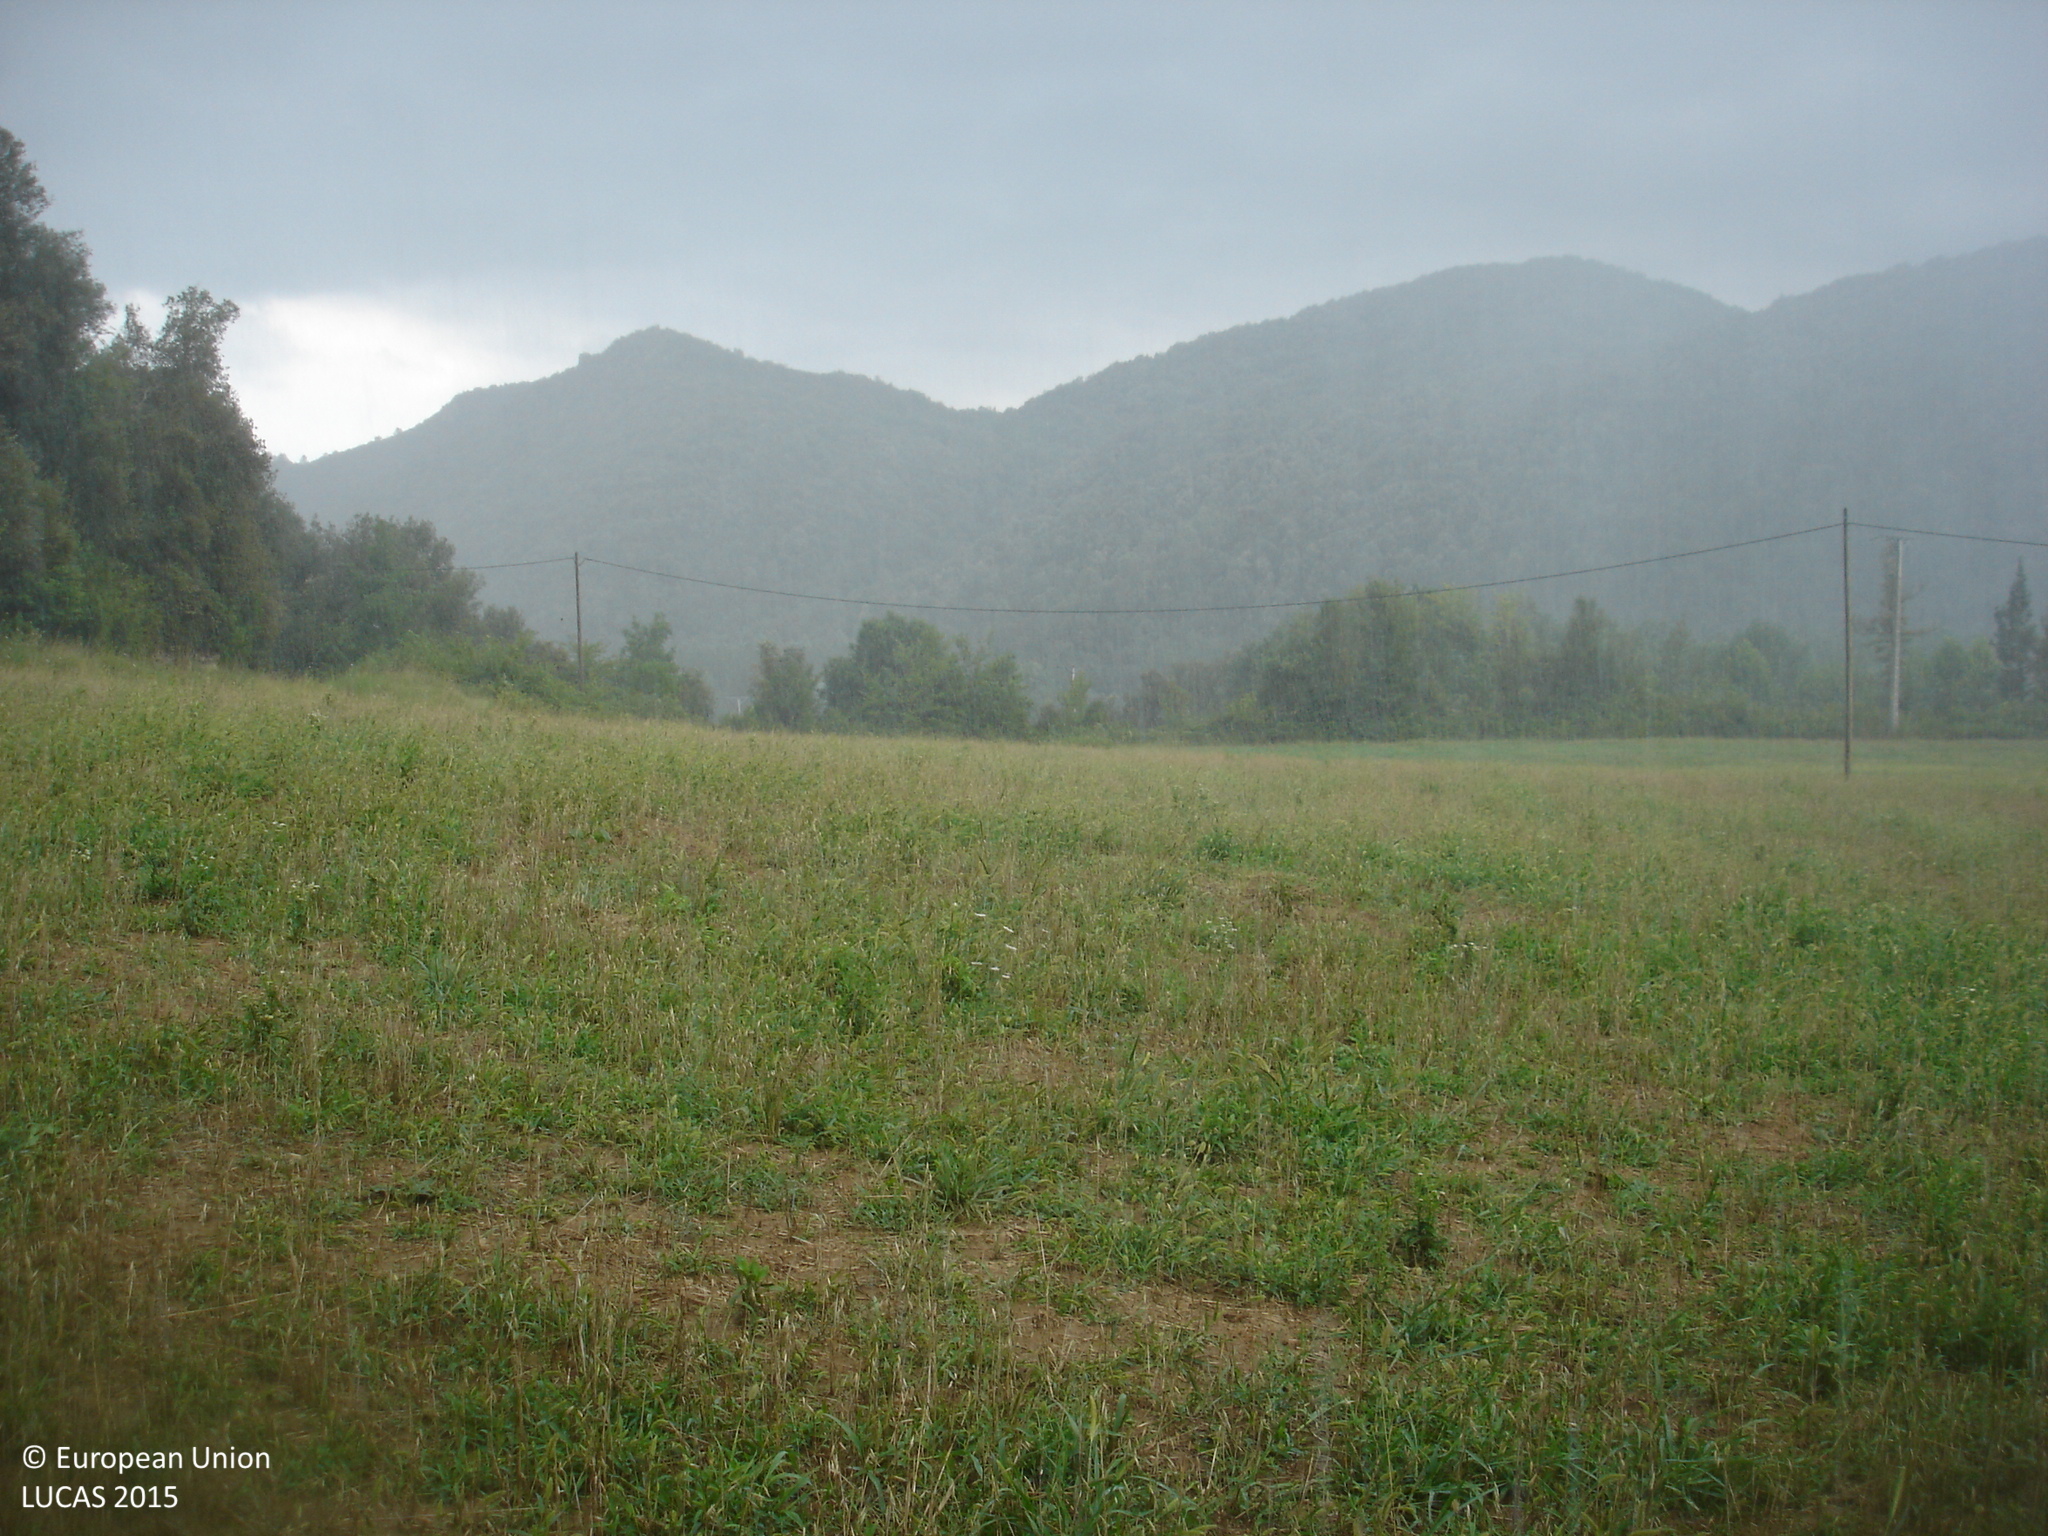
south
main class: Woodland
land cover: Broadleaved woodland
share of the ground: 10 - 25 %
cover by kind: herbaceous plants 55 %, shrubs 25 %, broadleaved forest trees 20 %
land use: Semi-natural and natural areas not in use
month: July
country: ES
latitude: 42.0753
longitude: 2.6054
